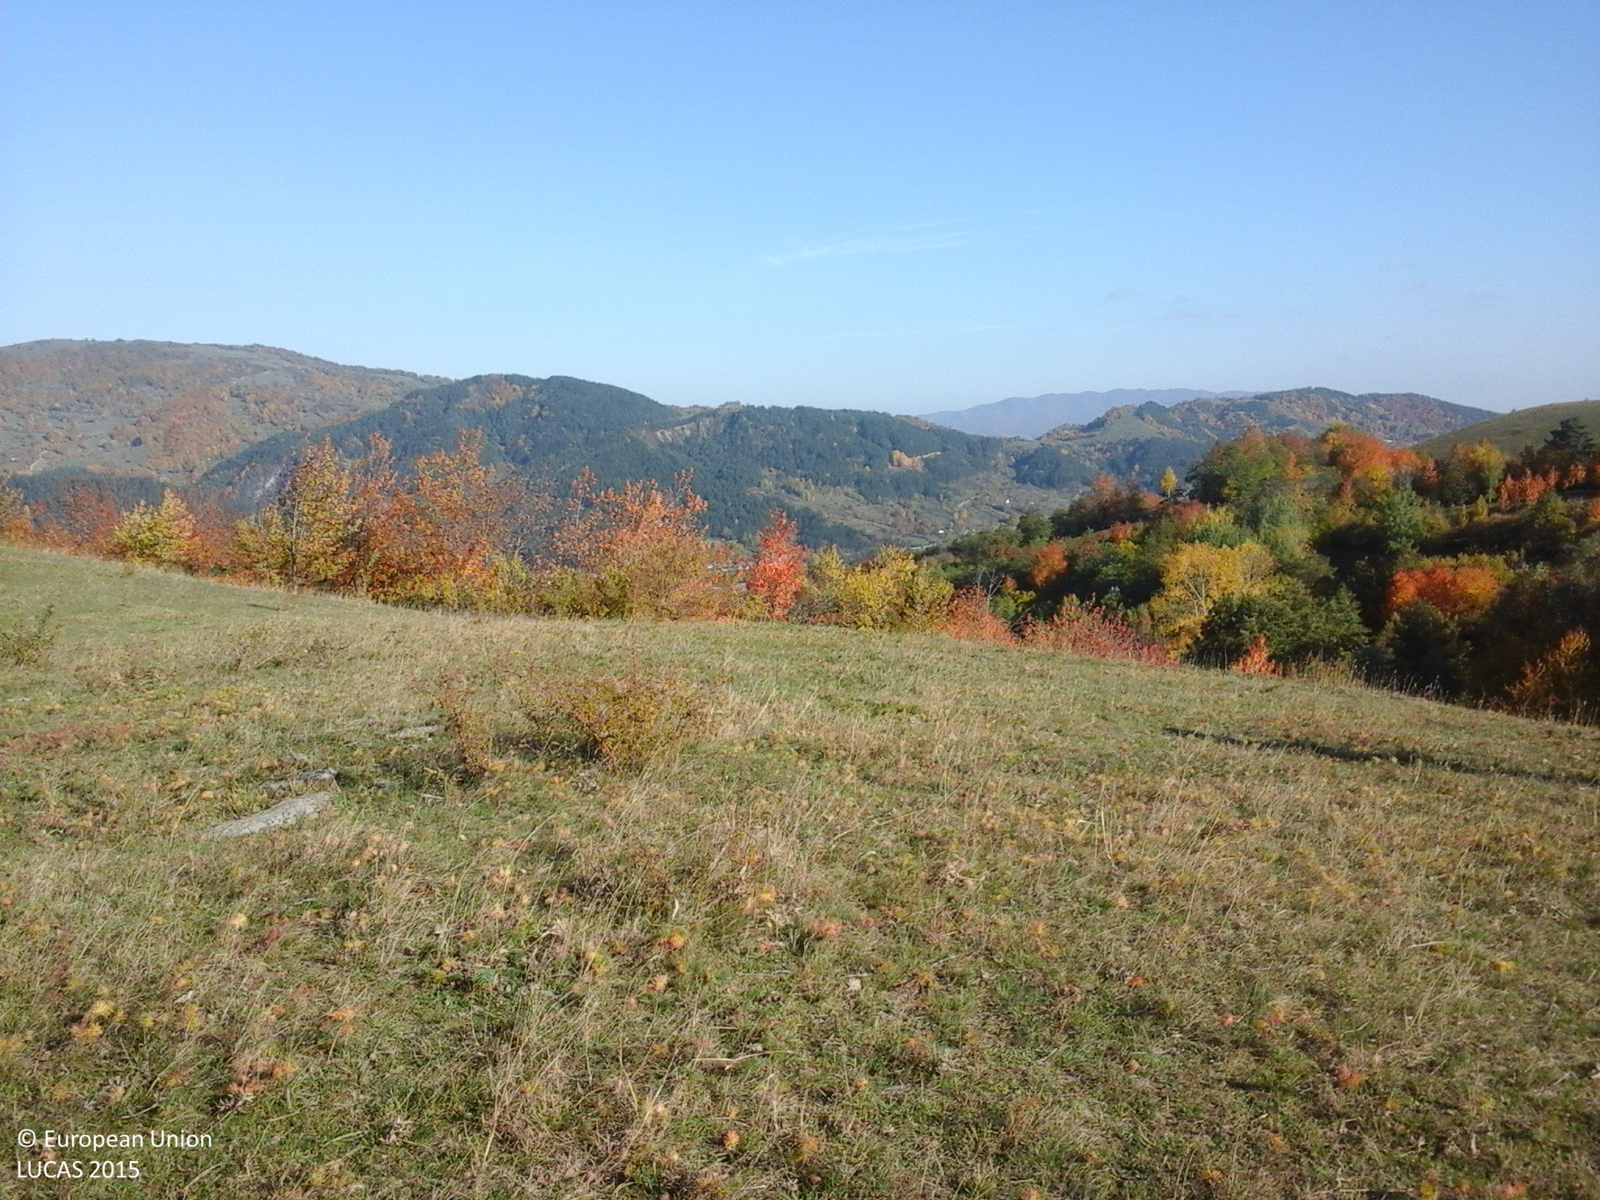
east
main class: Grassland
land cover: Grassland without tree/shrub cover
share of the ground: > 75 %
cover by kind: herbaceous plants 100 %
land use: Agriculture (excluding fallow land and kitchen gardens)
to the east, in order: Grassland without tree/shrub cover; Grassland with sparse tree/shrub cover; Broadleaved woodland
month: October
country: RO
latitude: 45.9046
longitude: 26.7250
